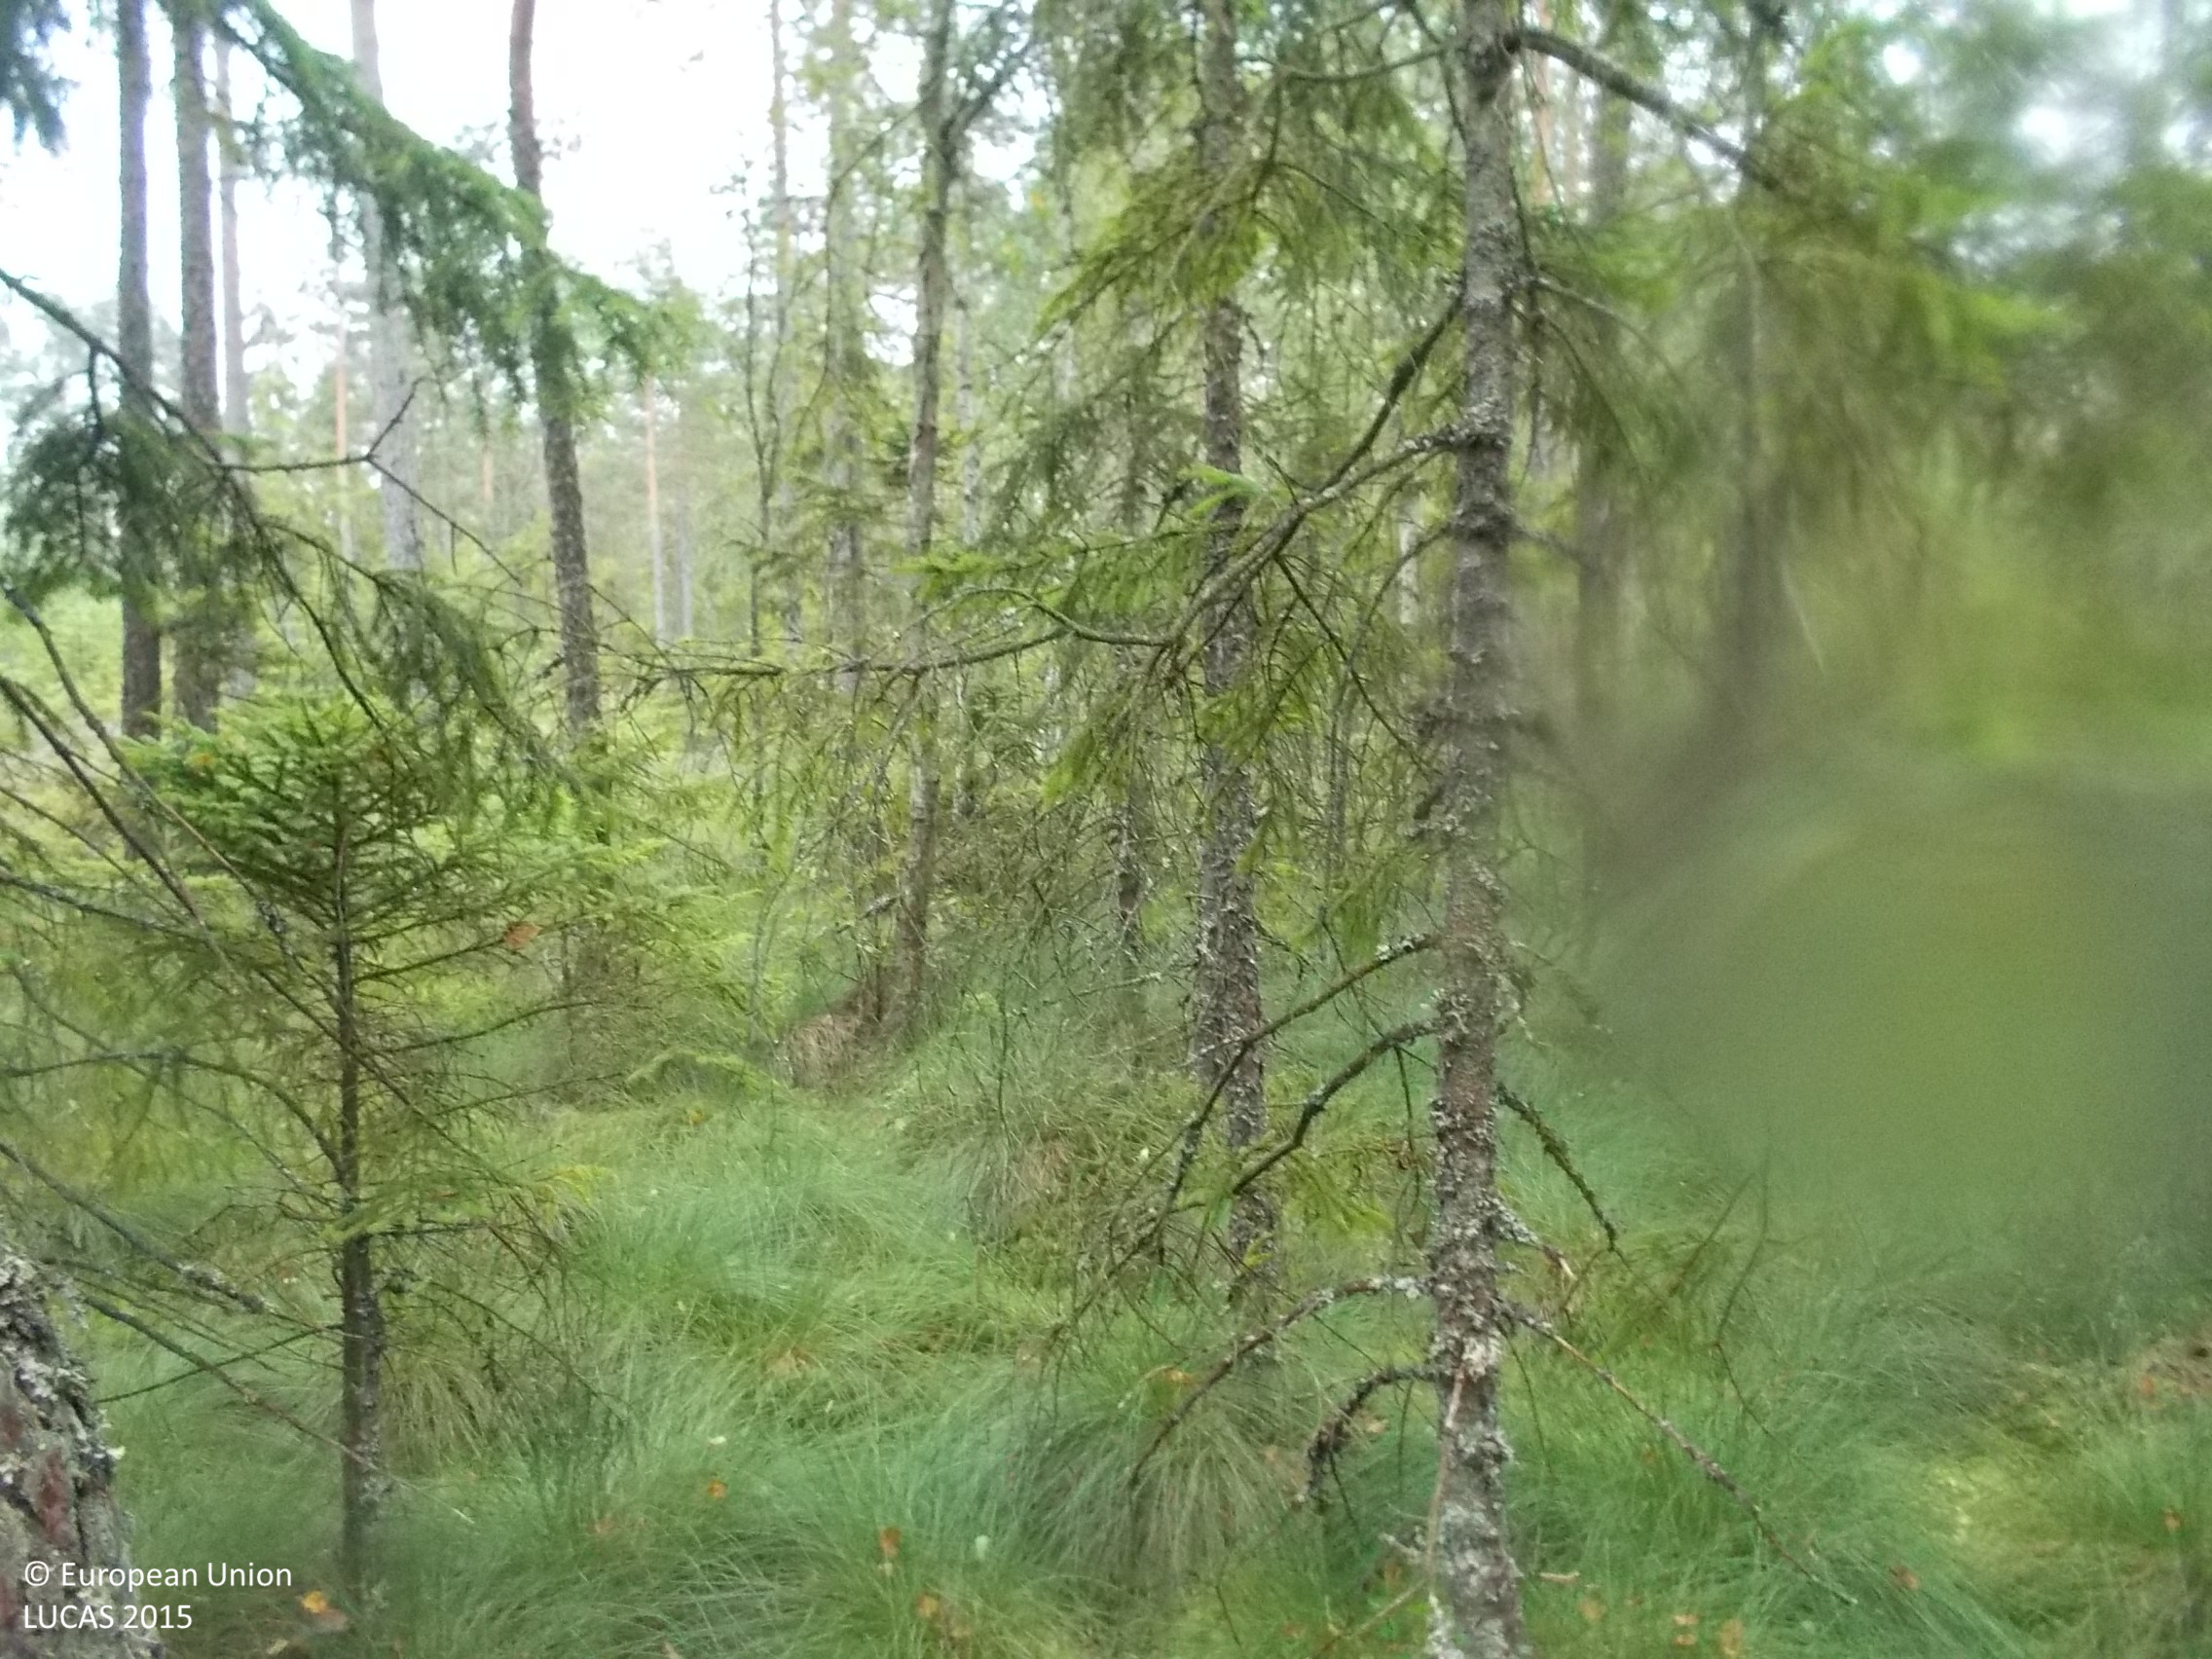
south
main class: Woodland
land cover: Pine dominated mixed woodland
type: boreal forest
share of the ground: > 75 %
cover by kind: coniferous forest trees 60 %, broadleaved forest trees 25 %, shrubs 10 %, lichens and mosses 5 %
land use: Forestry
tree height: > 5 m
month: August
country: SE
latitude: 57.3526
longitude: 13.2368
